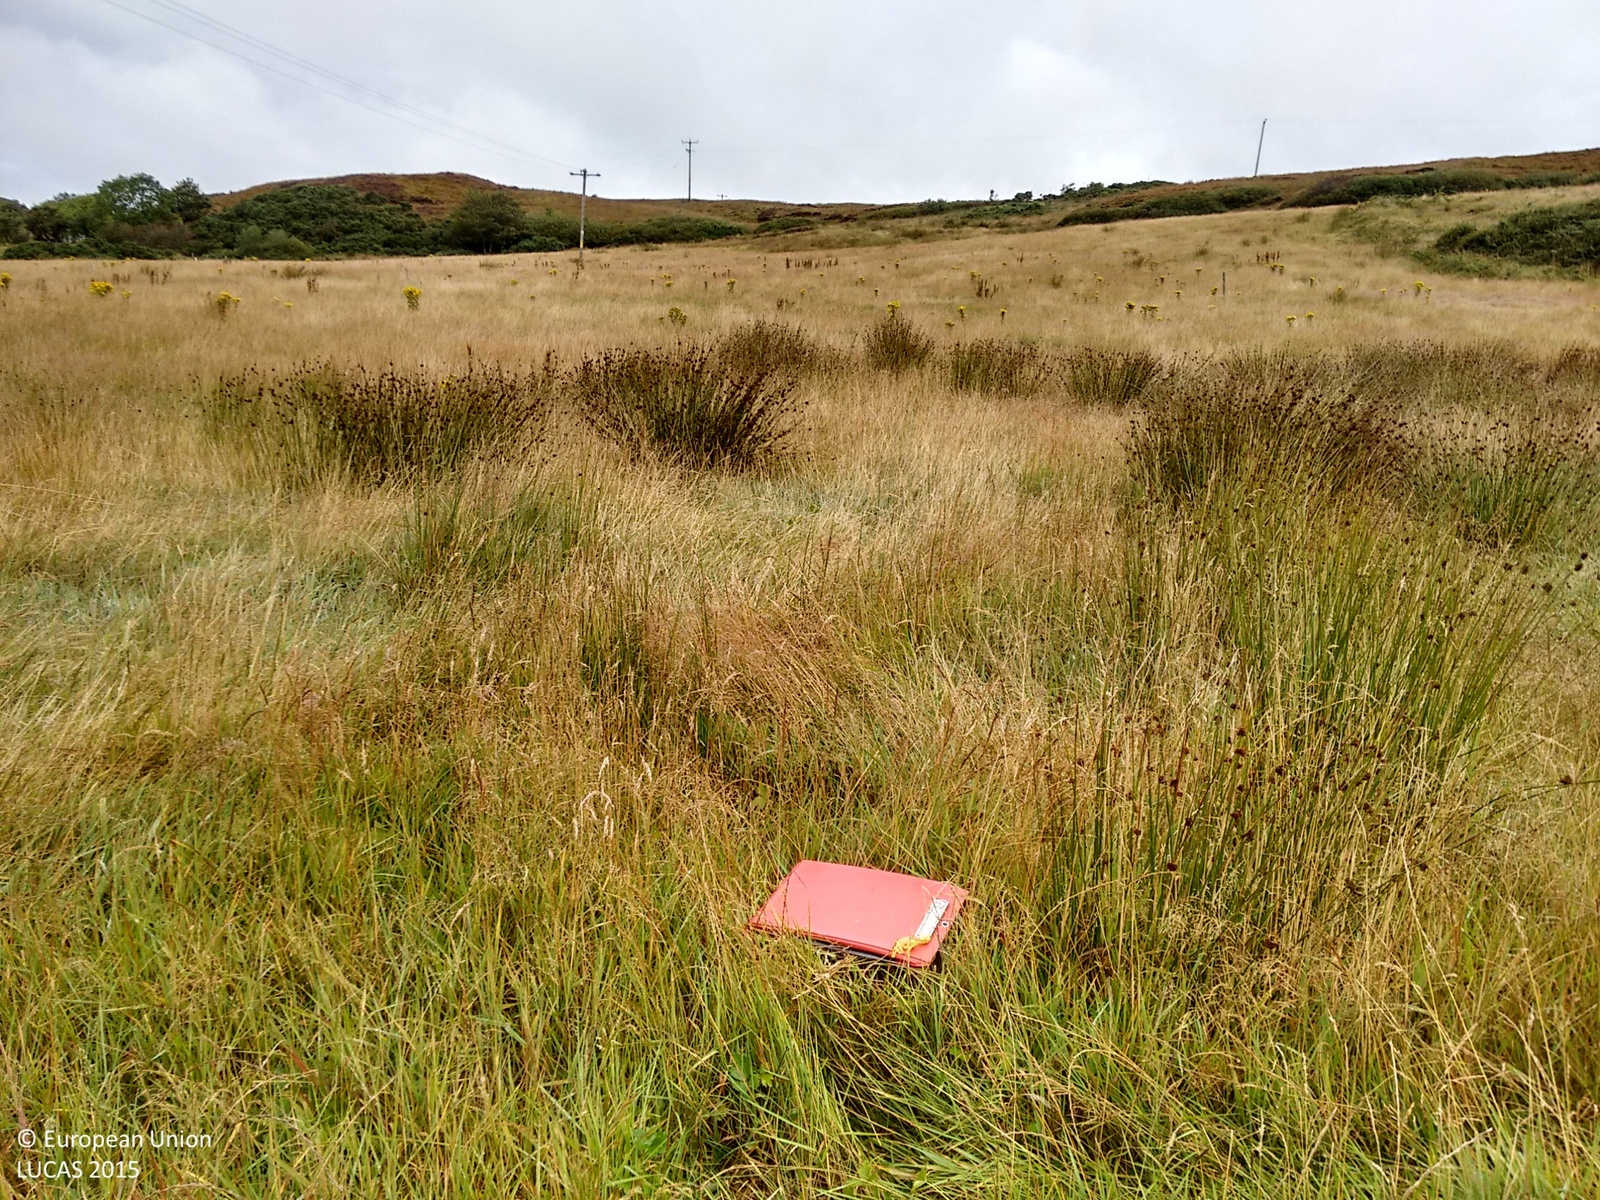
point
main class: Grassland
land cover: Grassland without tree/shrub cover
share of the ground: > 75 %
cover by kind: herbaceous plants 100 %
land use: Agriculture (excluding fallow land and kitchen gardens)
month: September
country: IE
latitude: 55.3159
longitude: -7.2734
